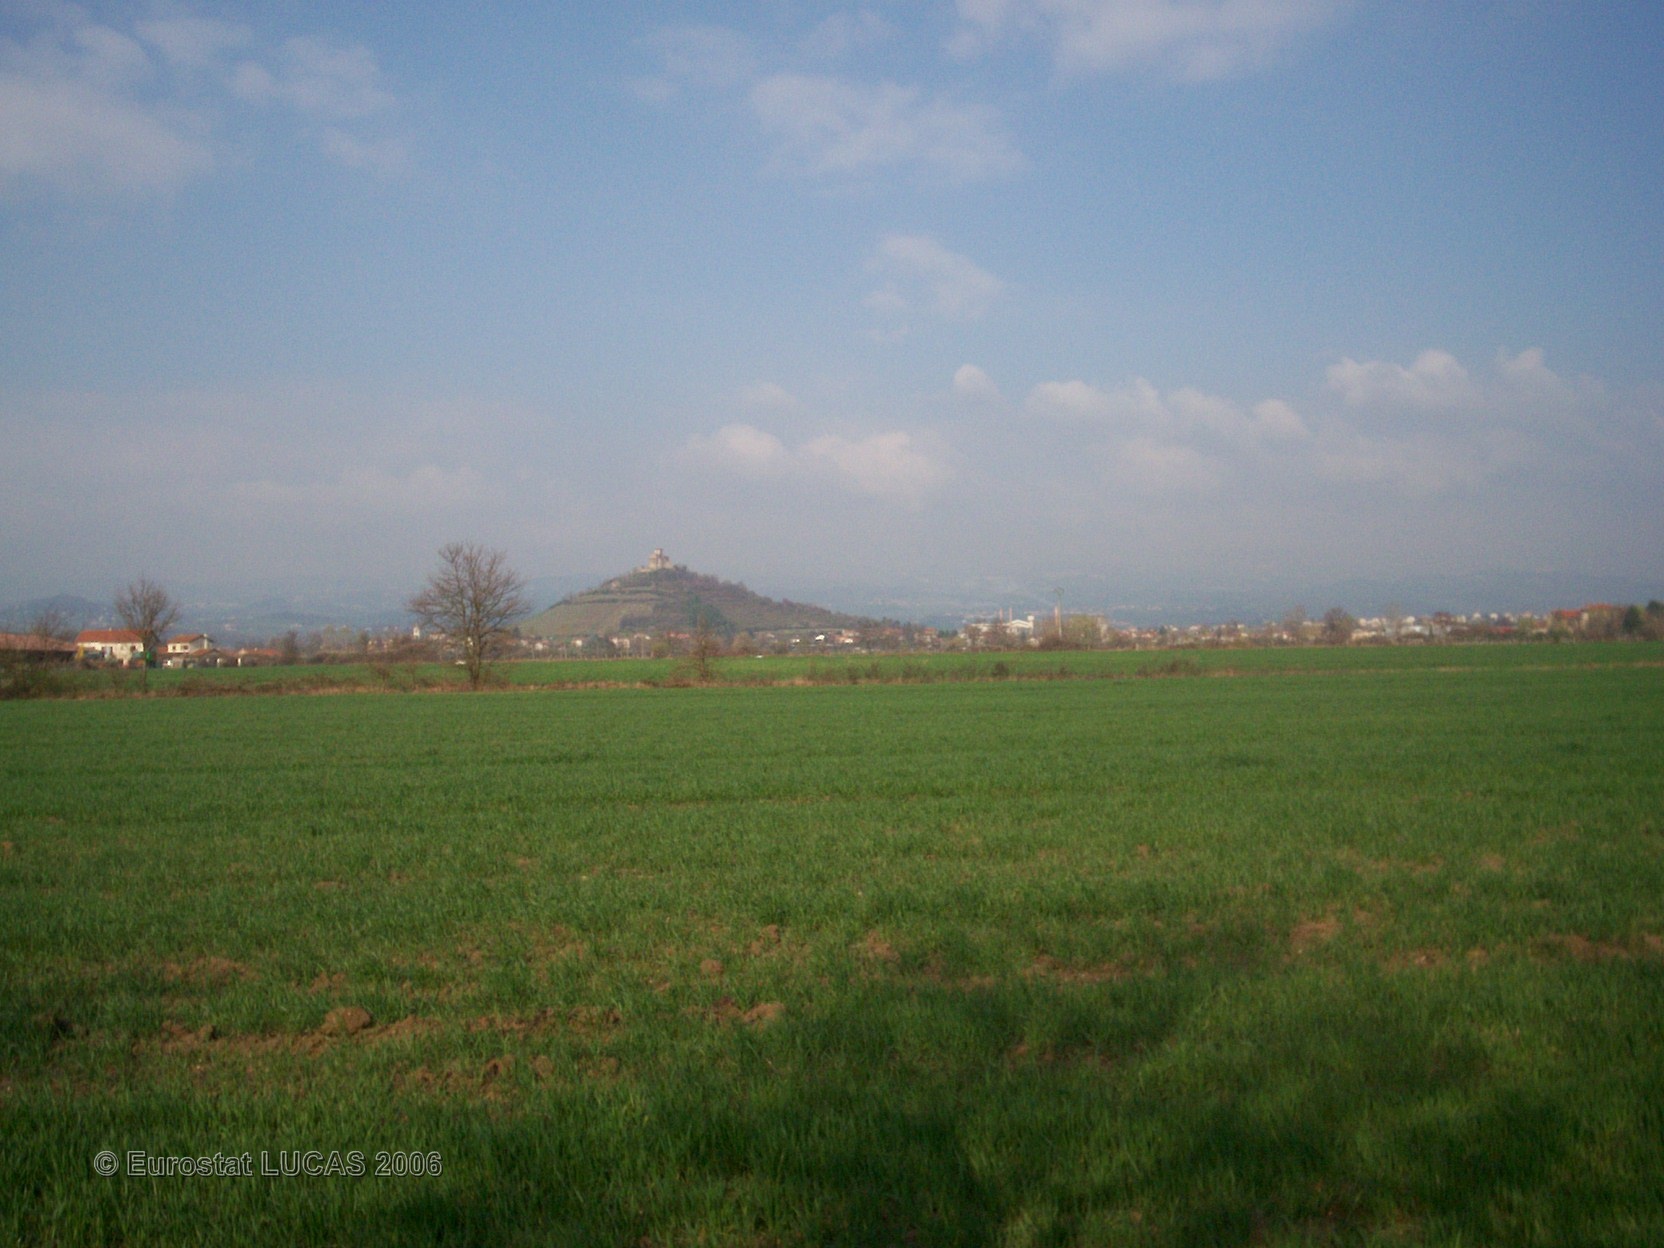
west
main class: Woodland
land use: Unused
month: April
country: FR
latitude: 45.5589
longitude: 4.1484
